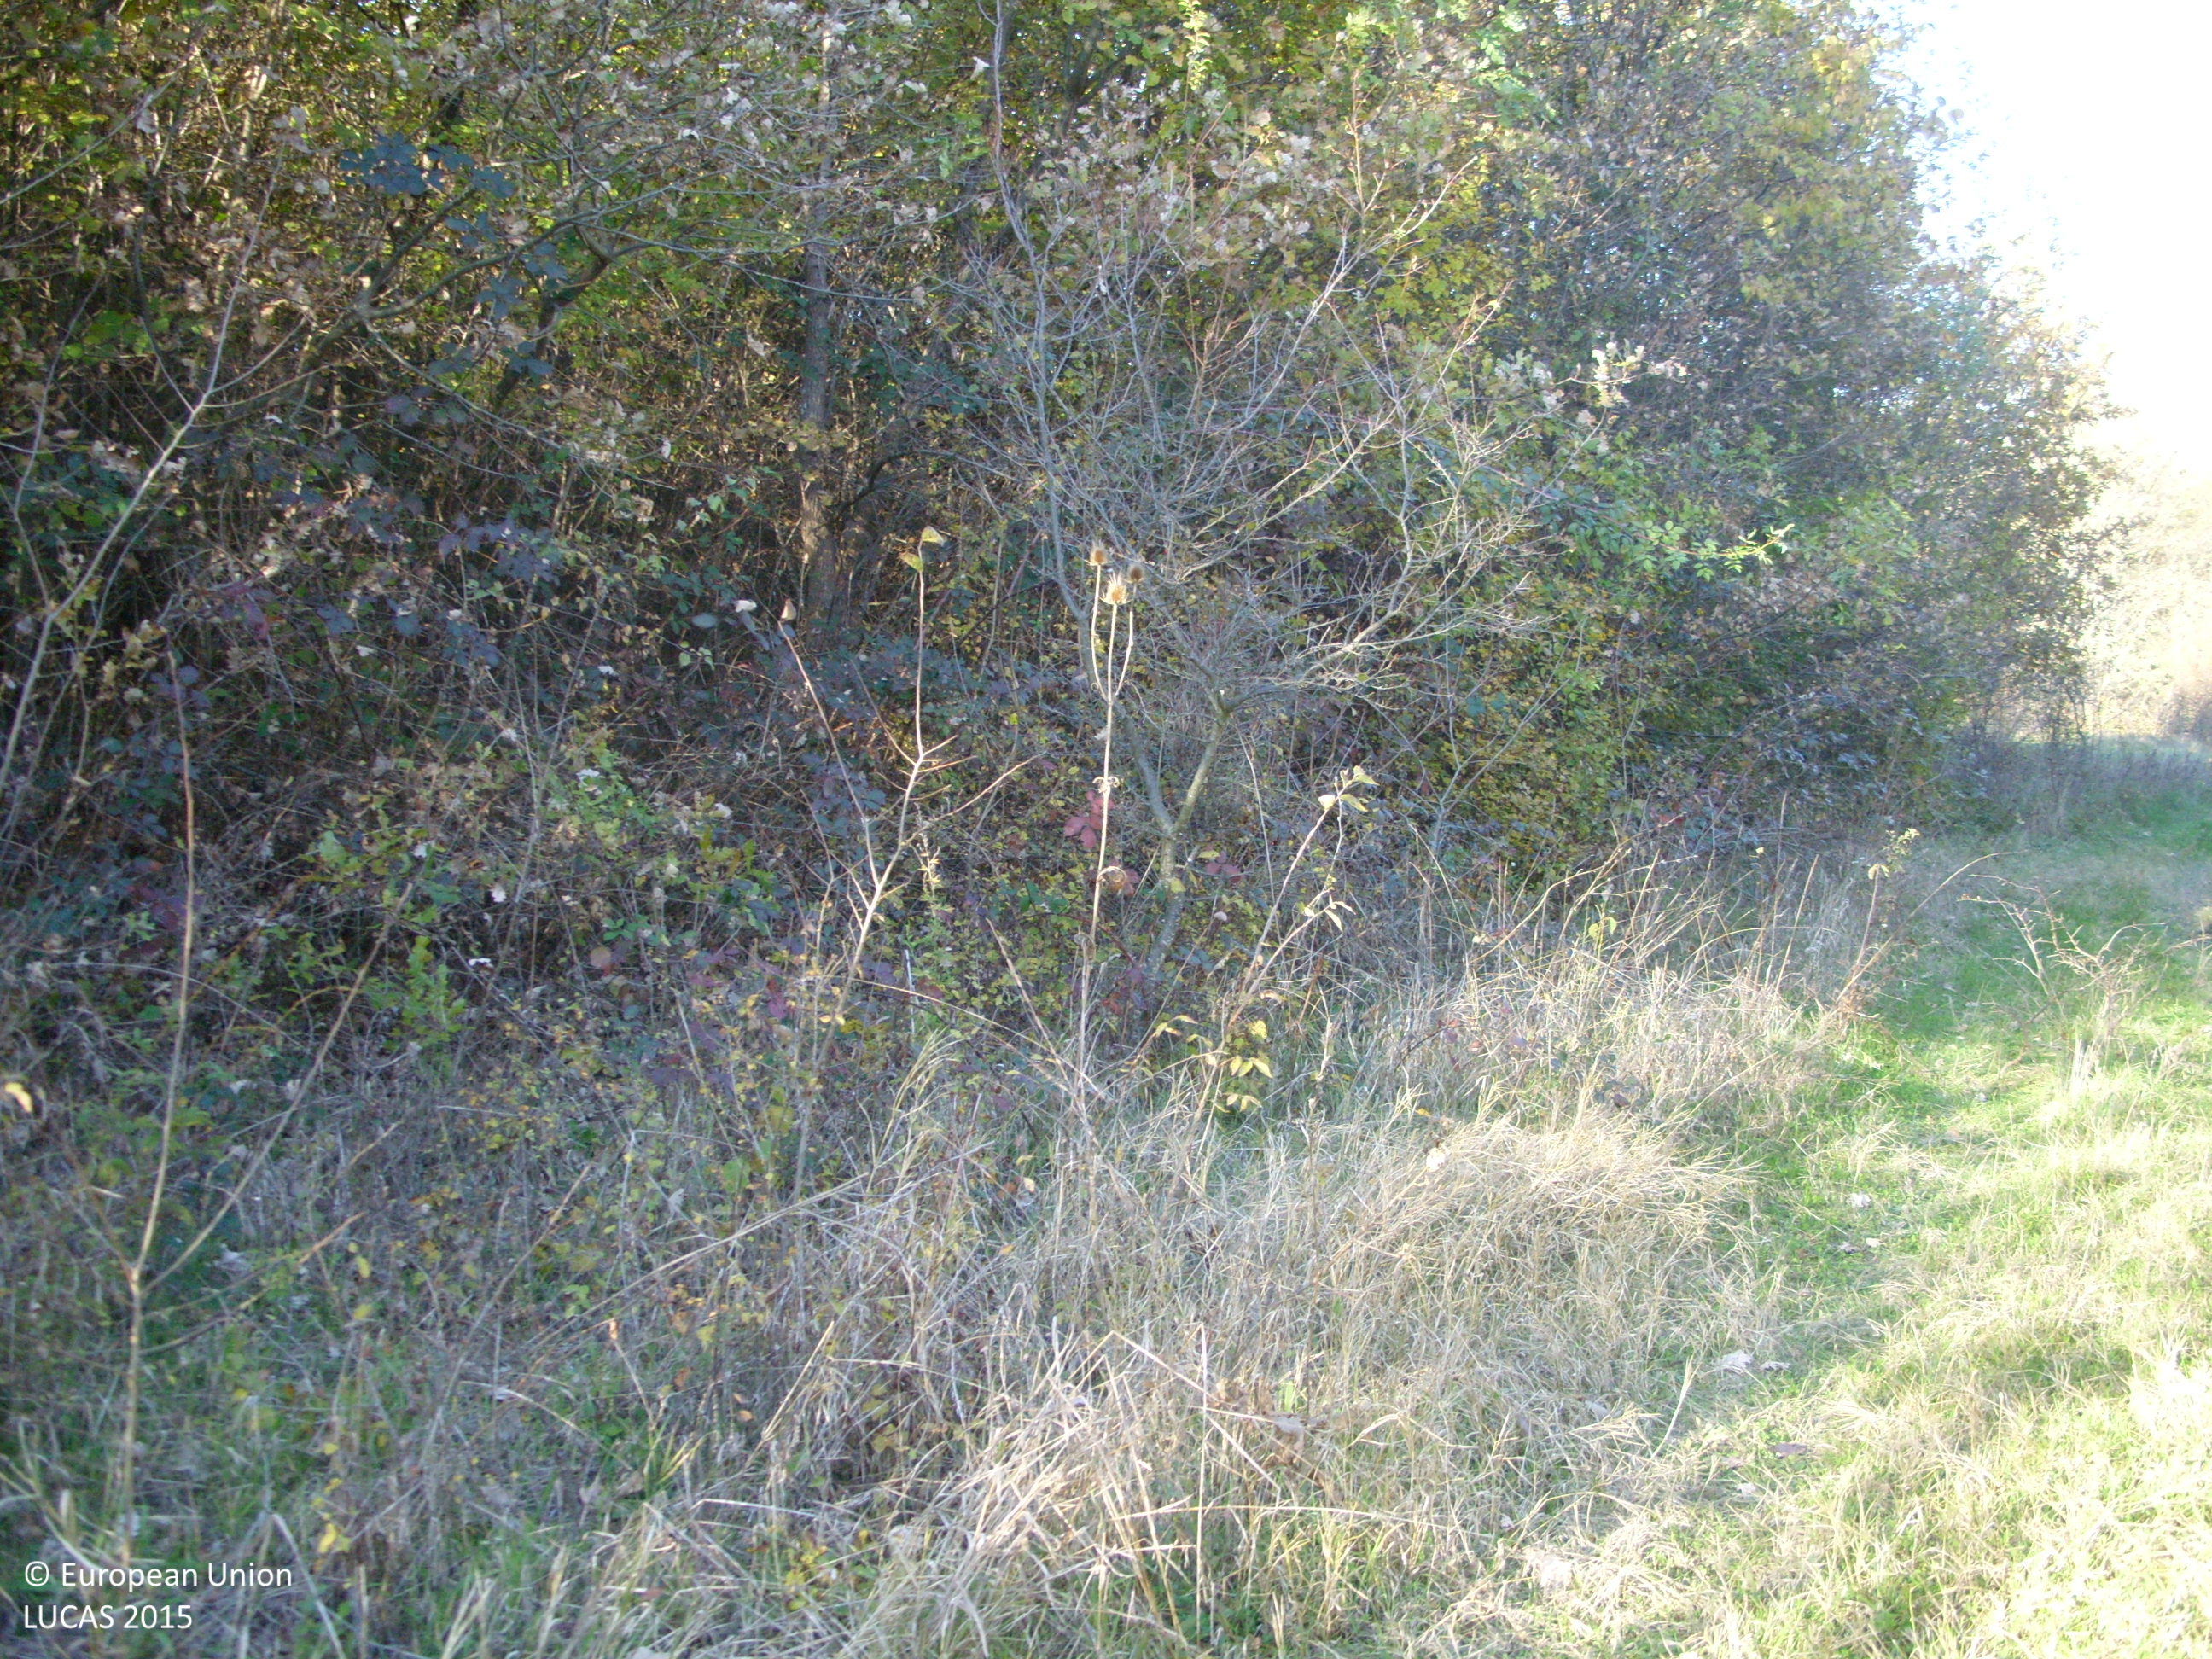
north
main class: Woodland
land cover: Broadleaved woodland
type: mesophytic deciduous forest
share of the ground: > 75 %
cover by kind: broadleaved forest trees 90 %, shrubs 5 %, unconsolidated bare surface 5 %
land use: Forestry
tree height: > 5 m
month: November
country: BG
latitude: 42.4005
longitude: 24.8170
